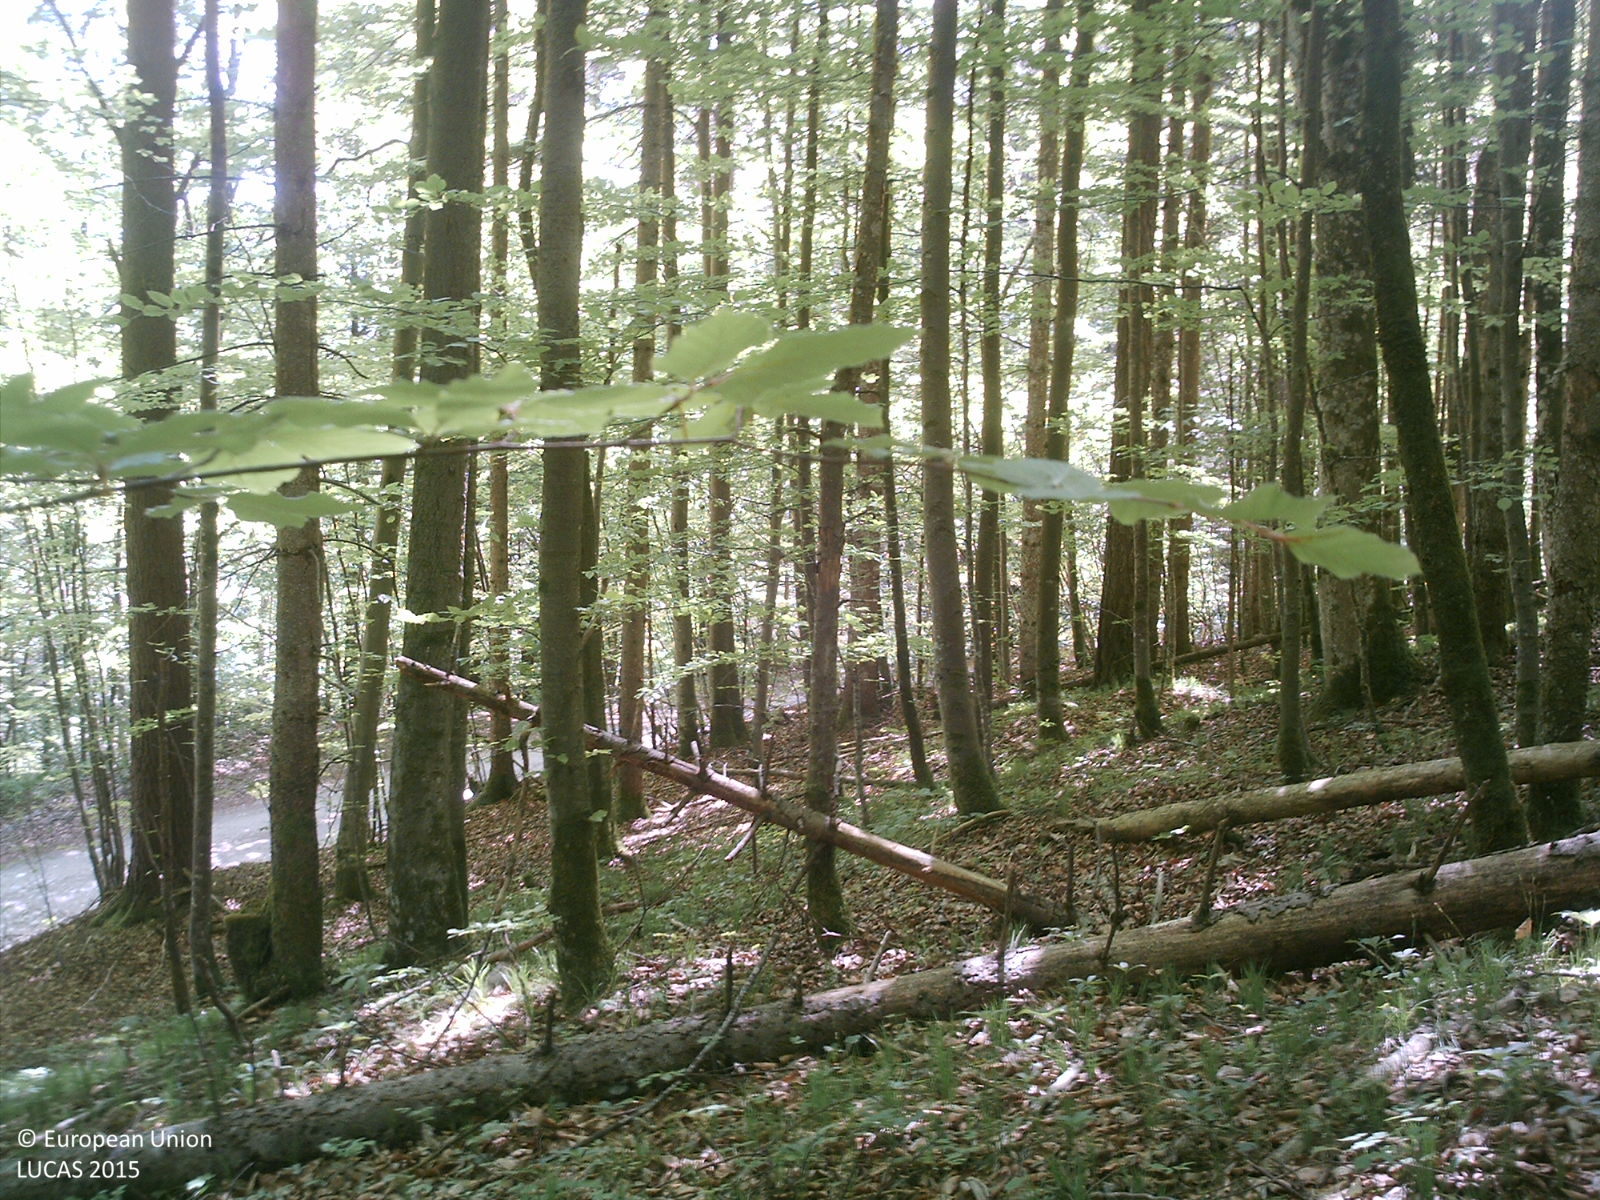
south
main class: Woodland
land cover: Broadleaved woodland
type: mountainous beech forest
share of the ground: > 75 %
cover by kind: broadleaved forest trees 90 %, coniferous forest trees 10 %
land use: Forestry
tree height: > 5 m
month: May
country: AT
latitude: 47.8389
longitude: 14.1547
